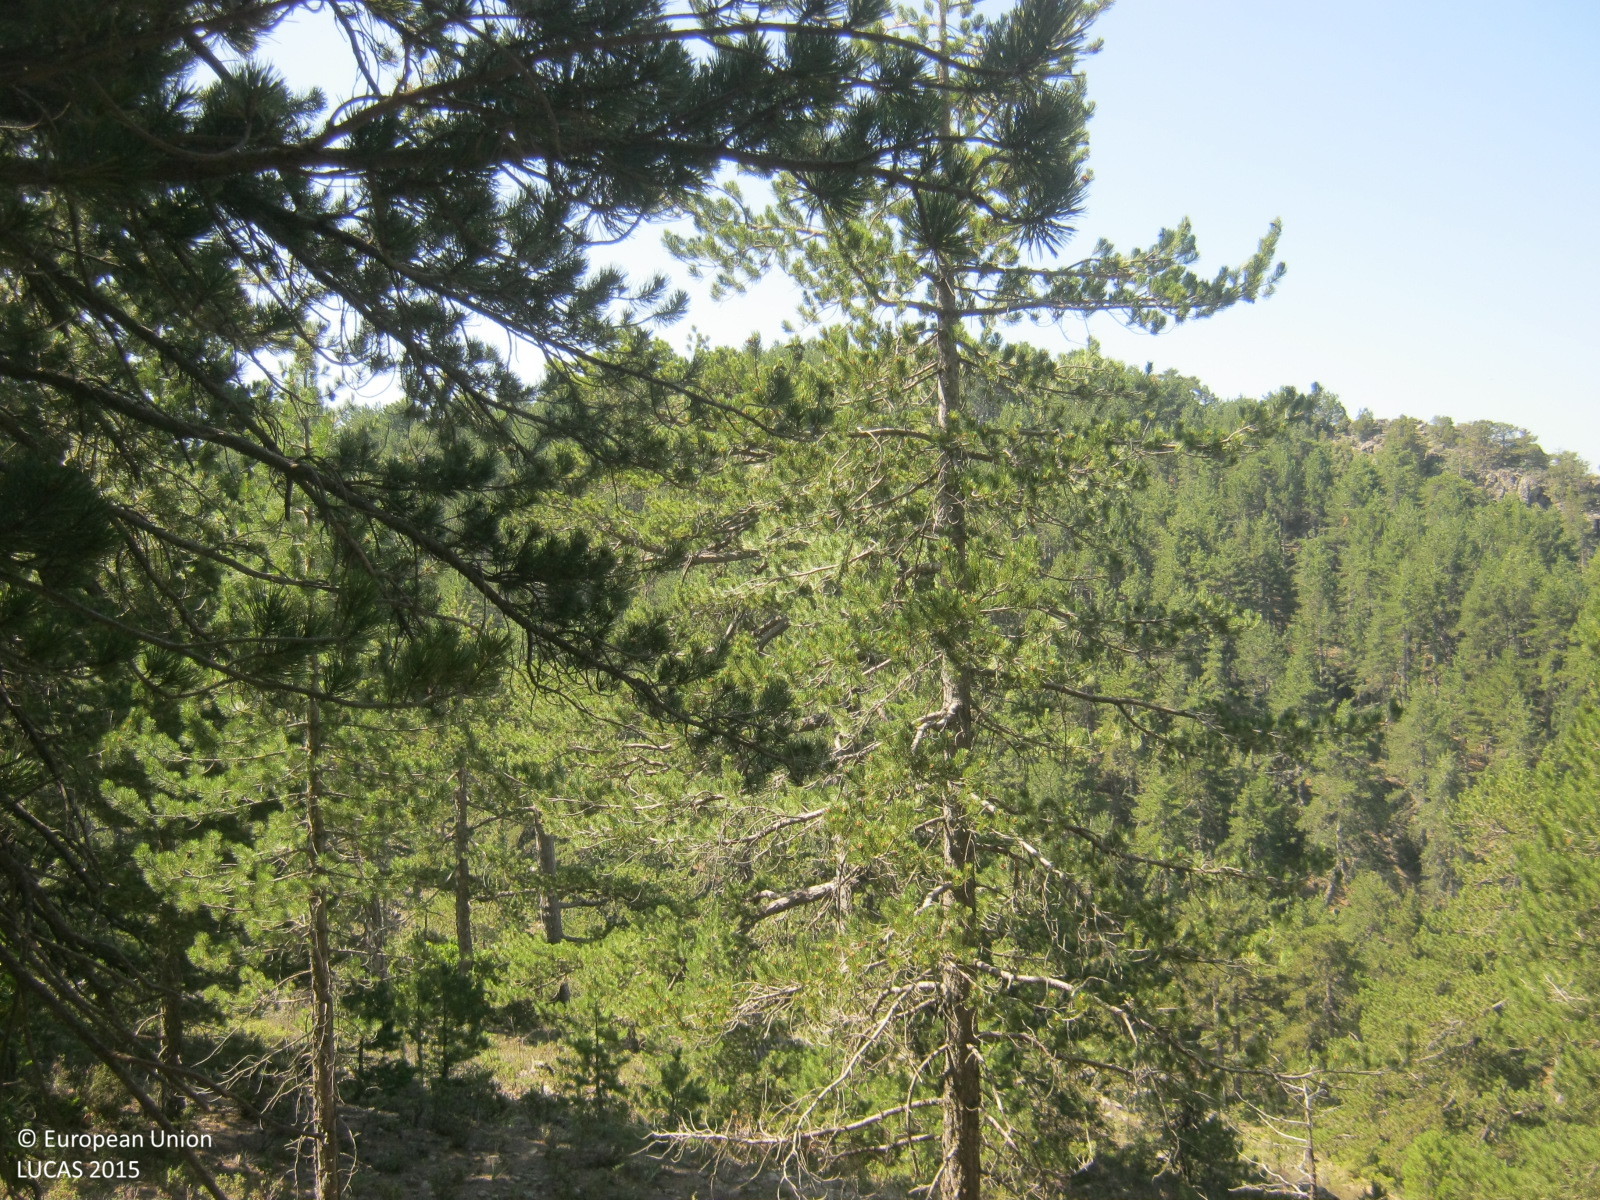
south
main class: Woodland
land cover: Pine dominated coniferous woodland
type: coniferous forest of the mediterranean region
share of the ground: > 75 %
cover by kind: coniferous forest trees 80 %, shrubs 10 %, broadleaved forest trees 5 %, unconsolidated bare surface 5 %
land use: Forestry
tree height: > 5 m
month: June
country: CY
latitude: 34.9465
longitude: 32.8427
